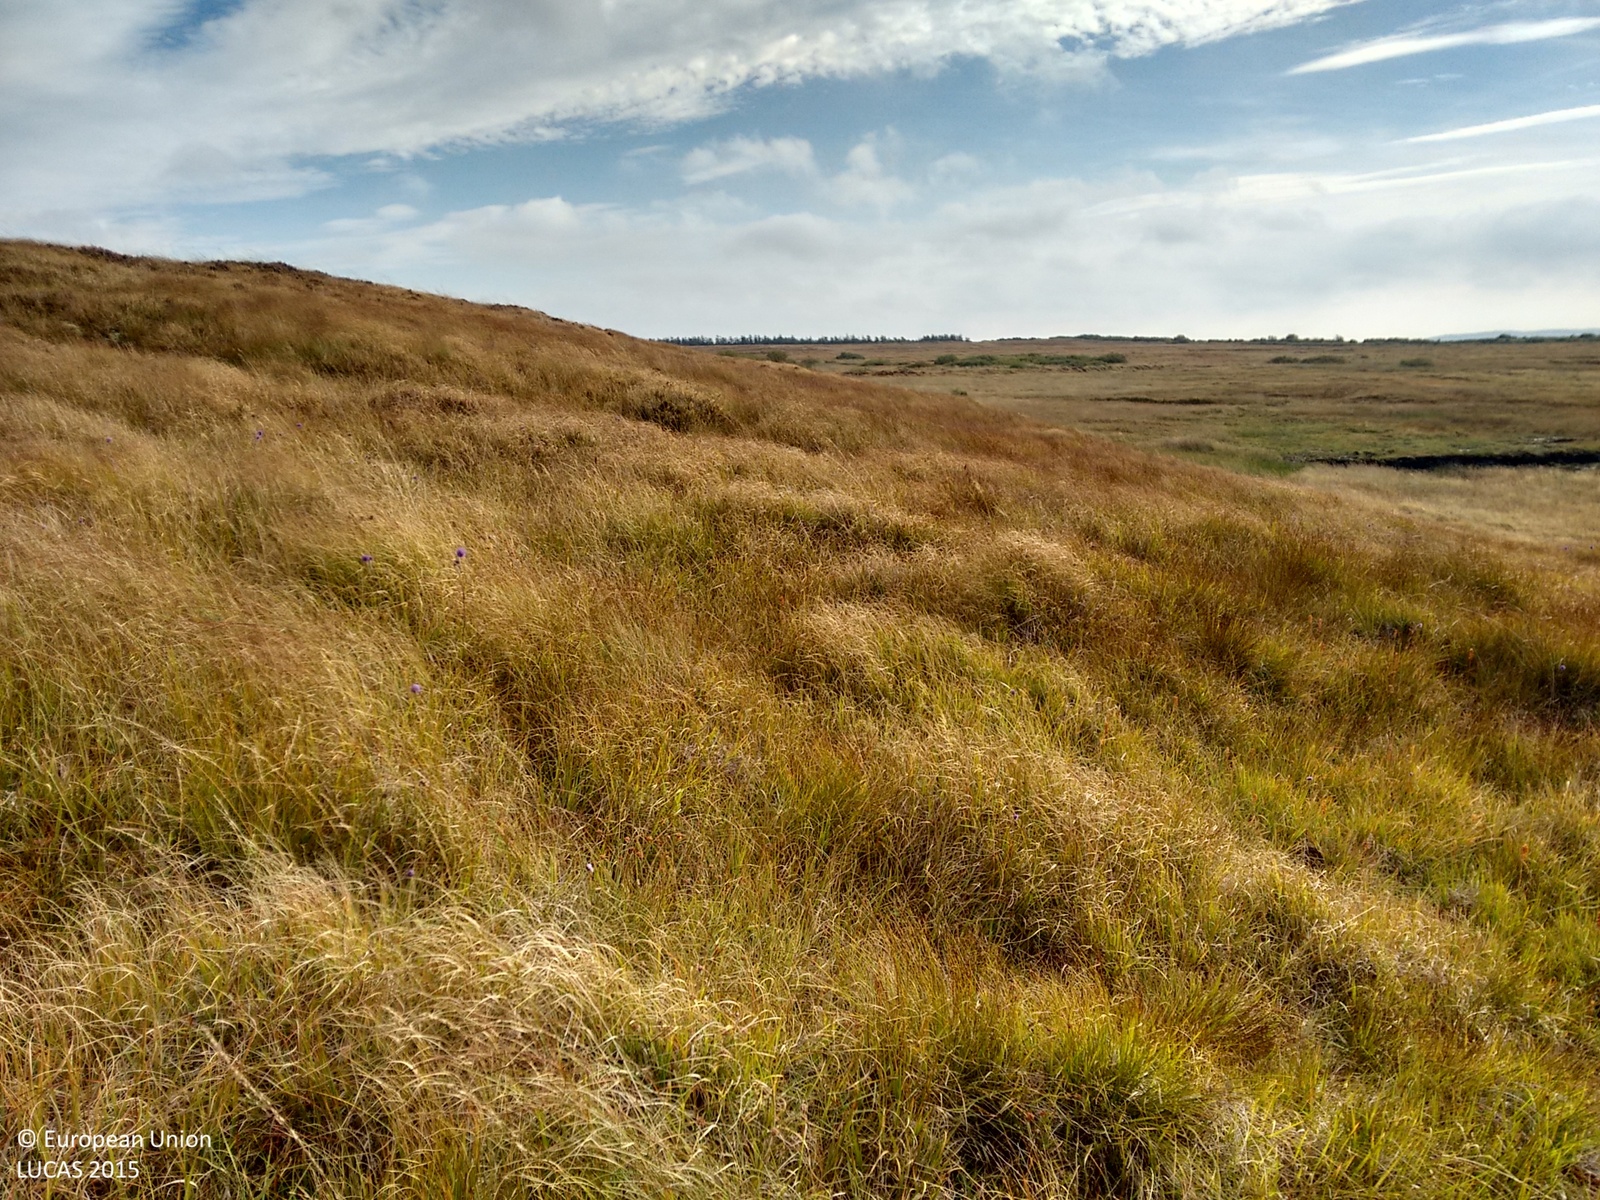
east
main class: Woodland
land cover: Spruce dominated coniferous woodland
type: exotic forest
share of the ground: > 75 %
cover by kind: coniferous forest trees 100 %
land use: Forestry
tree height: > 5 m
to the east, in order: Spruce dominated coniferous woodland; Grassland without tree/shrub cover; Fences; Peatbogs
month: September
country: IE
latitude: 52.9451
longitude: -9.2568
